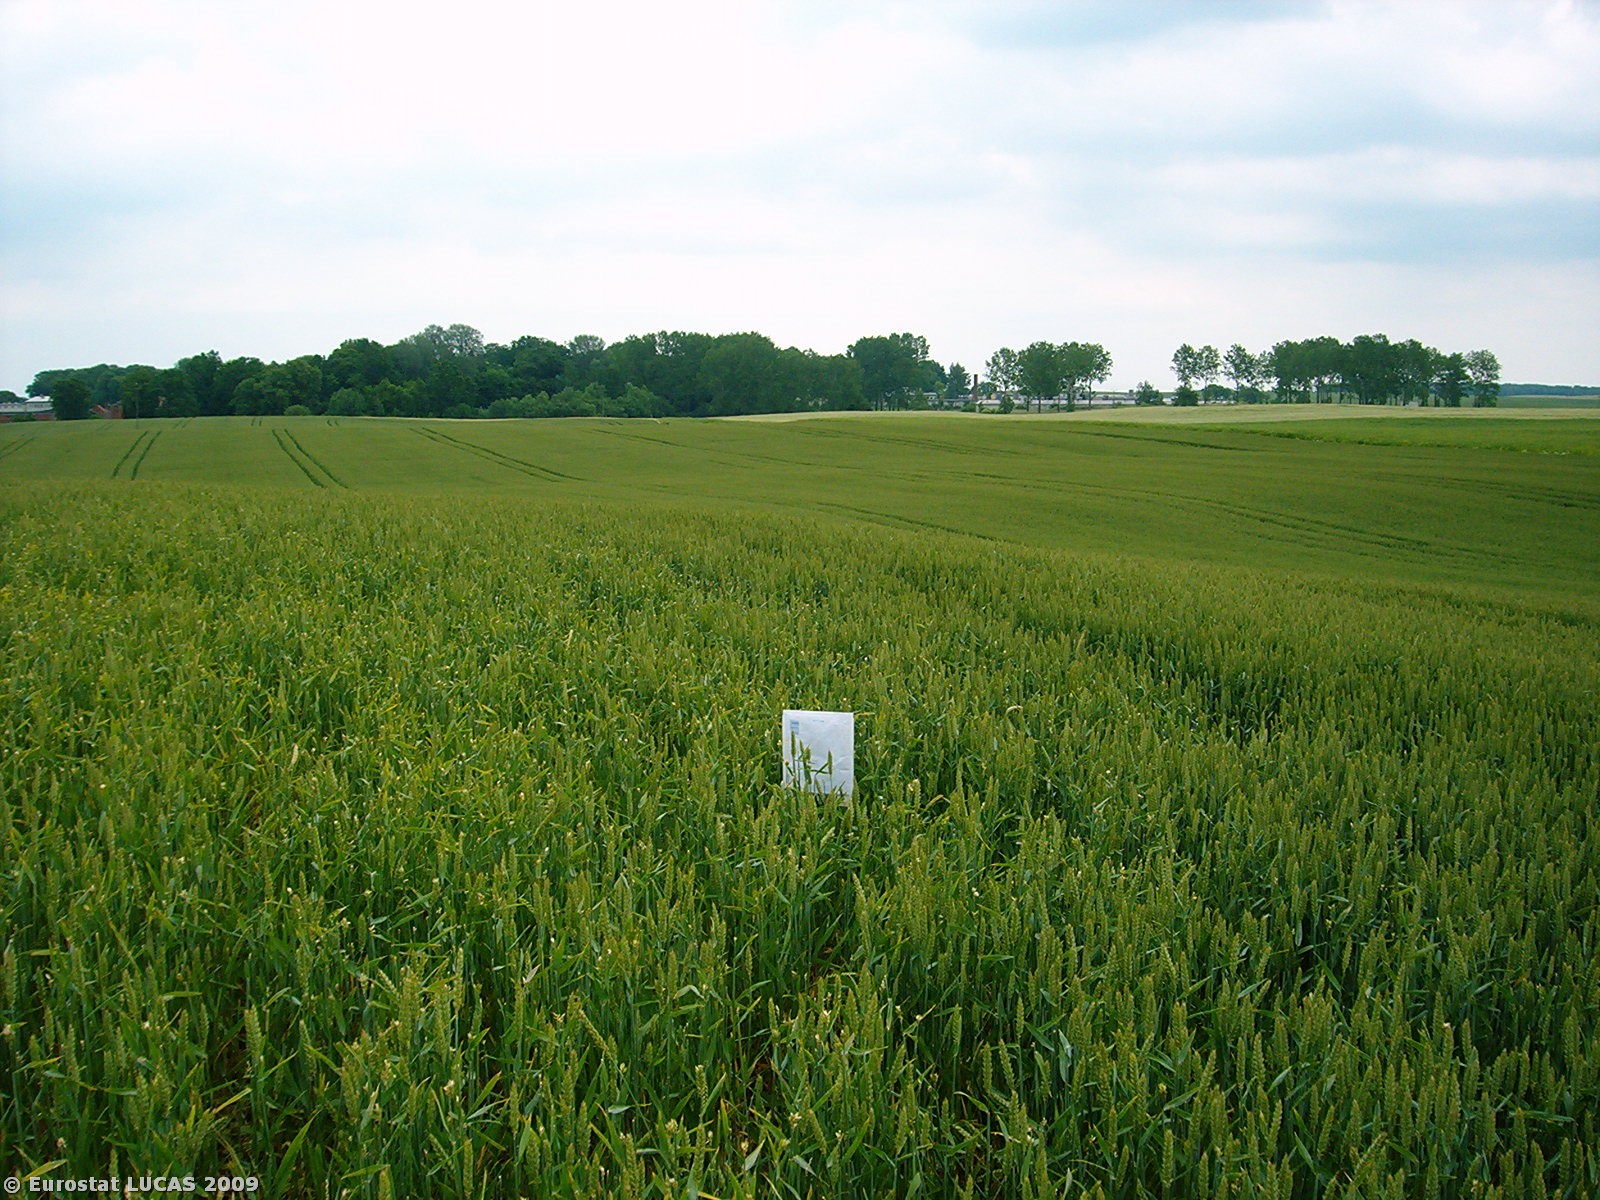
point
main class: Cropland
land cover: Common wheat
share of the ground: > 75 %
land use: Agriculture (excluding fallow land and kitchen gardens)
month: June
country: PL
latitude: 53.0273
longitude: 15.4456
